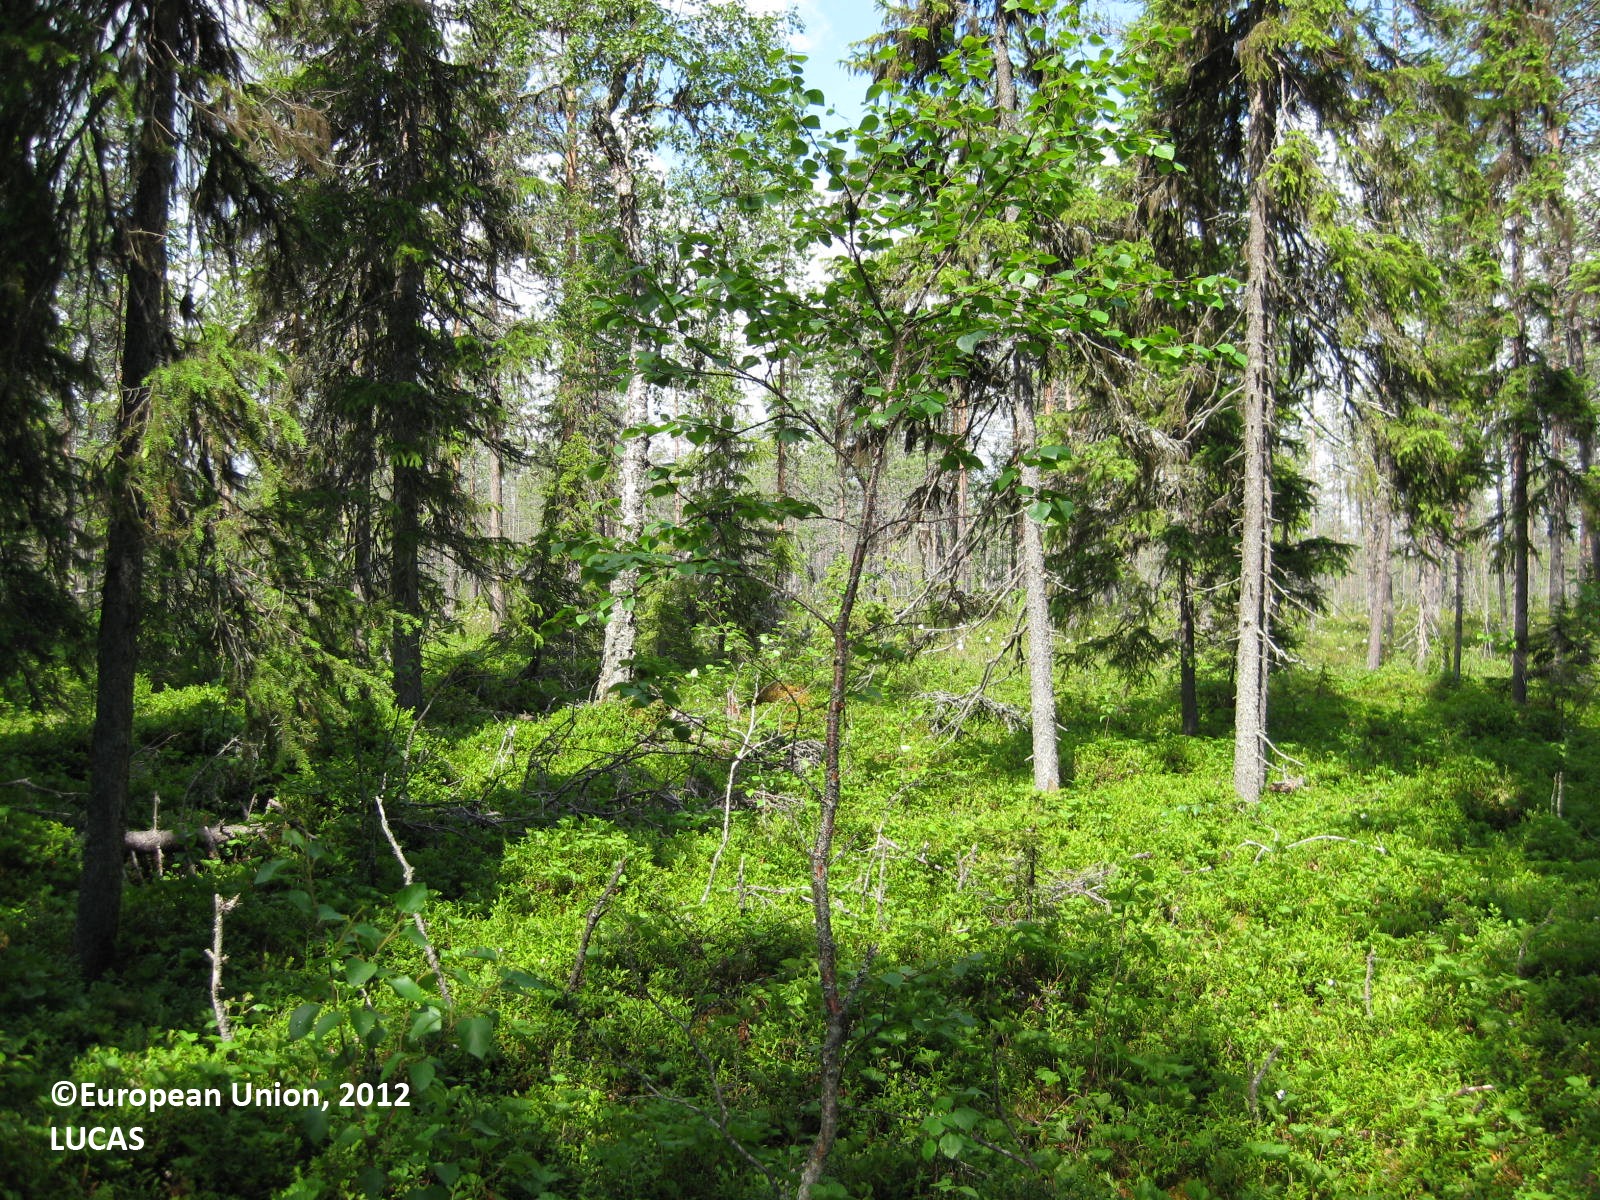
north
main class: Woodland
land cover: Spruce dominated coniferous woodland
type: boreal forest
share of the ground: > 75 %
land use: Forestry
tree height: > 5 m
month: July
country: FI
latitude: 65.6379
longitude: 29.5561
